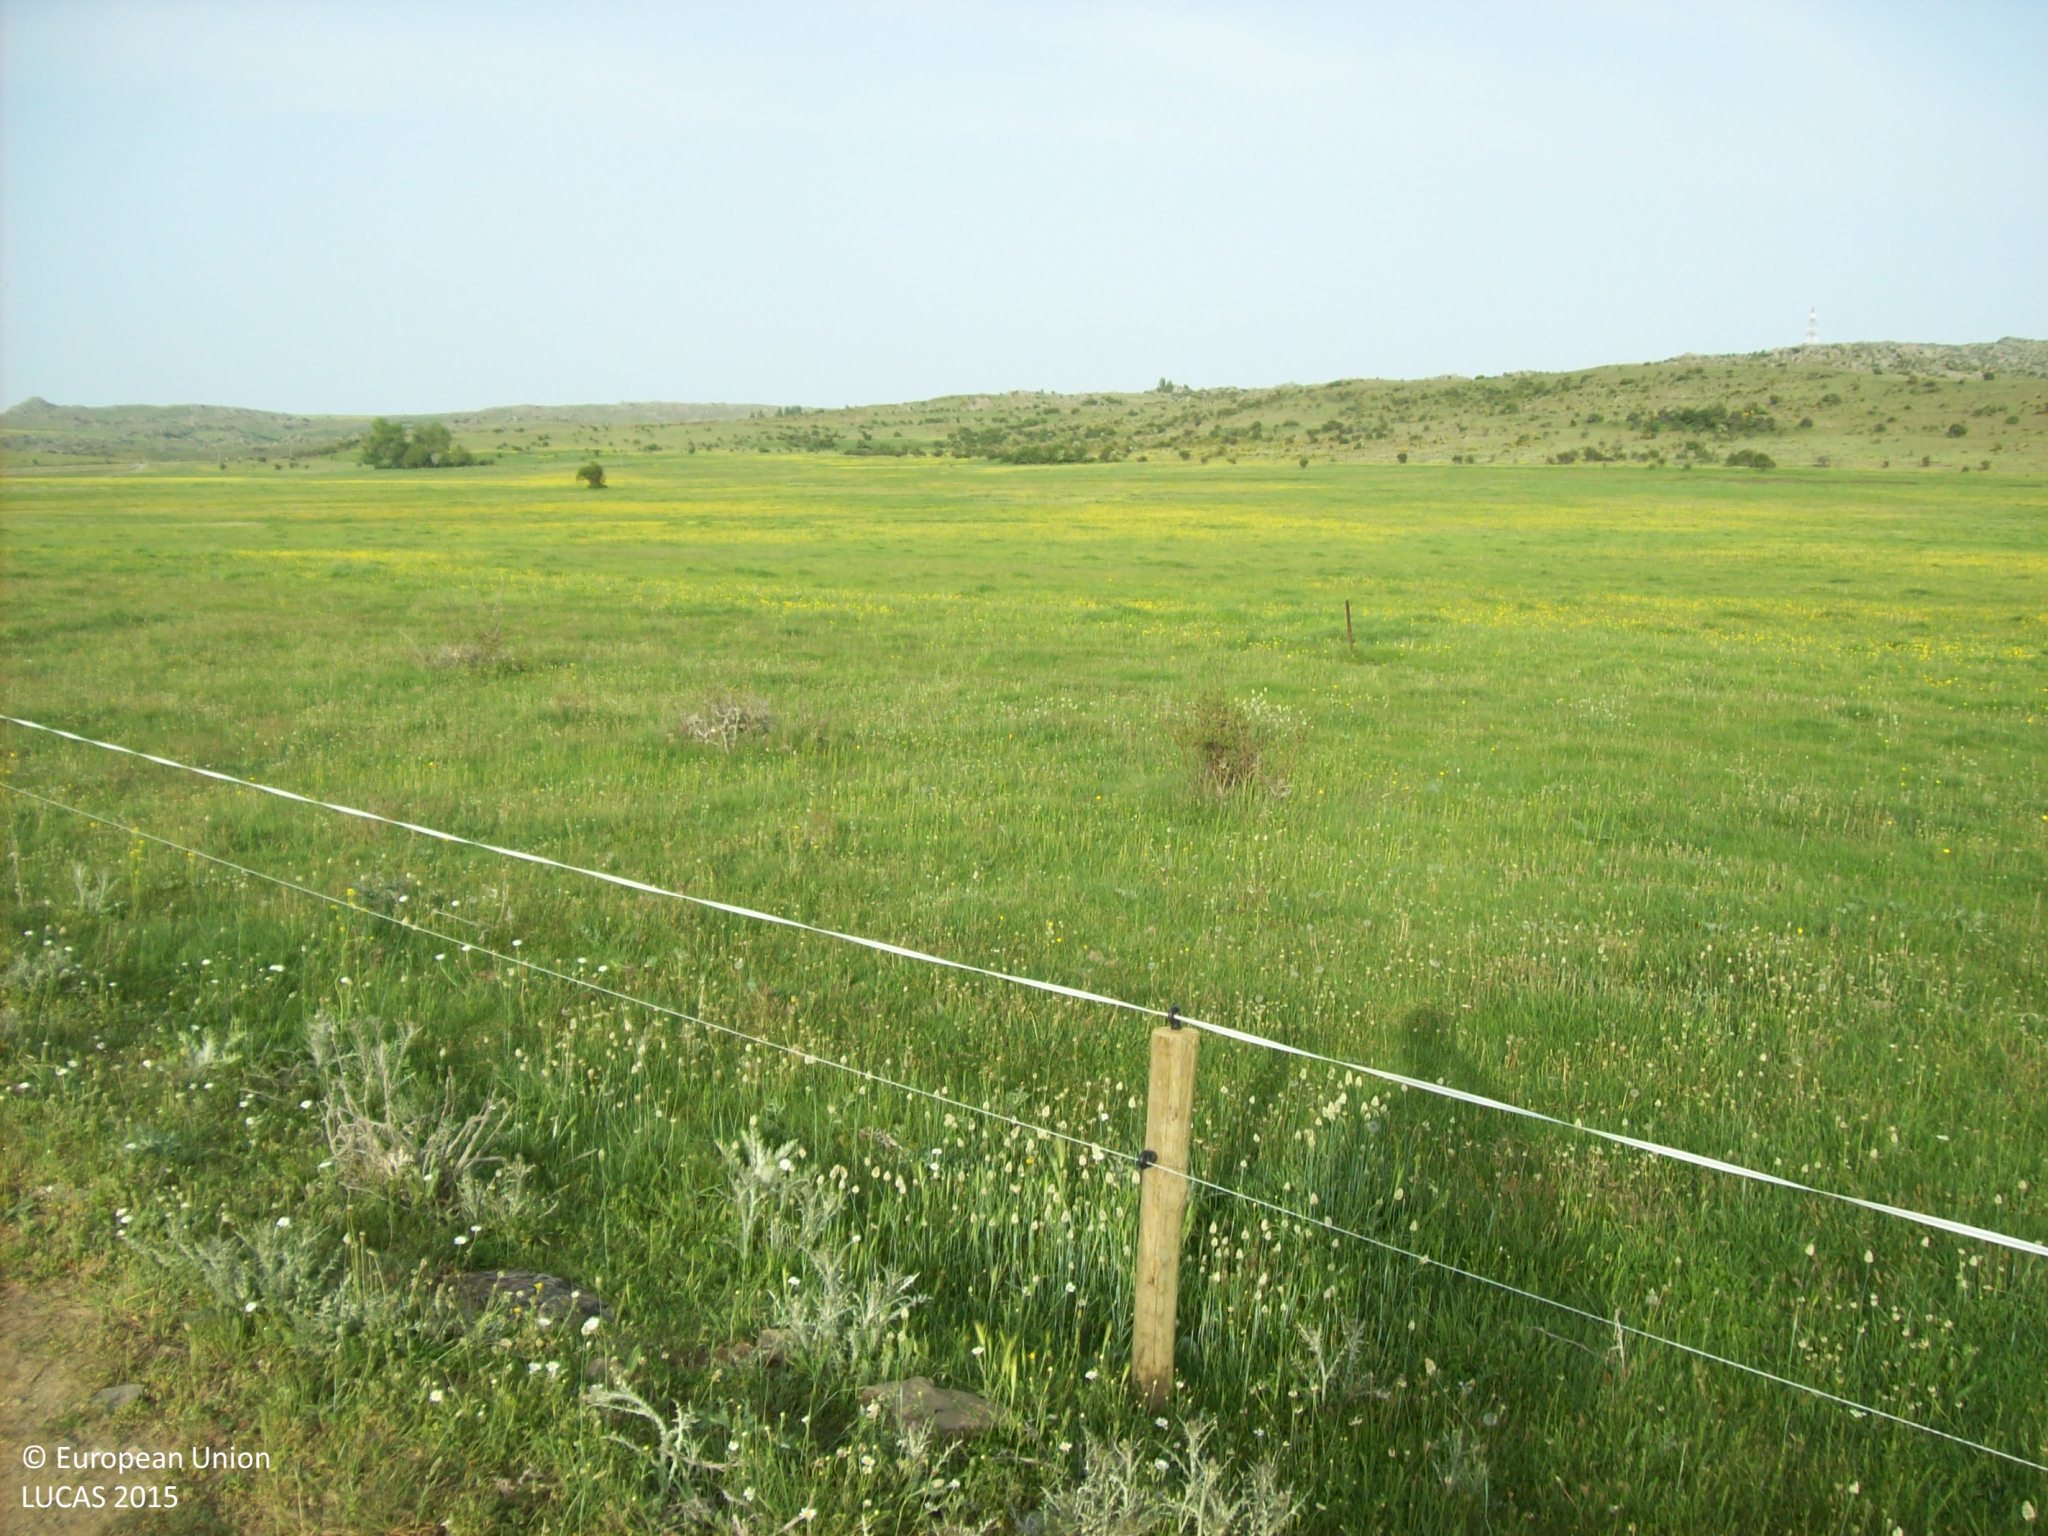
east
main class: Grassland
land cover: Grassland without tree/shrub cover
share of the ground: > 75 %
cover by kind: herbaceous plants 95 %
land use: Agriculture (excluding fallow land and kitchen gardens)
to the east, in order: Tracks; Grass margins; Fences; Grassland without tree/shrub cover; Grassland with sparse tree/shrub cover; Grassland without tree/shrub cover
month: May
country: ES
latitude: 40.6850
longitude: -4.8850
